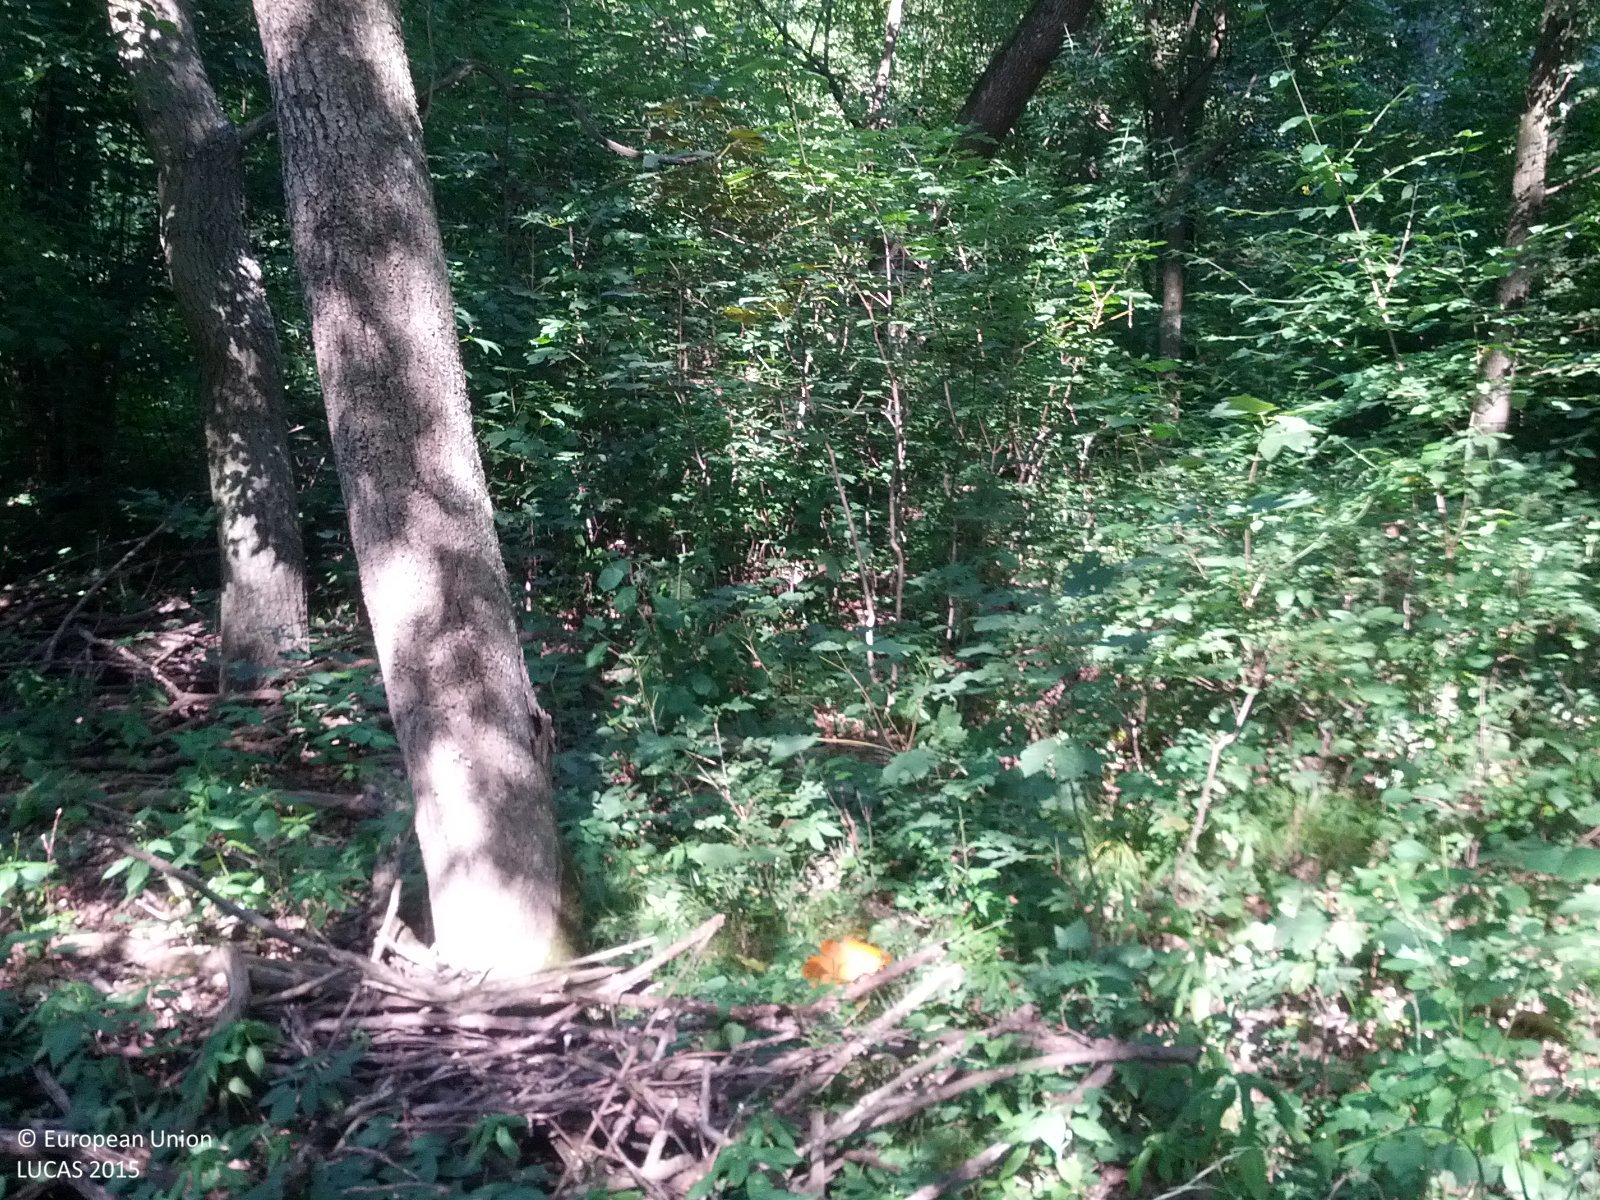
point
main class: Woodland
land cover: Broadleaved woodland
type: floodplain forest
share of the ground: > 75 %
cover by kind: broadleaved forest trees 80 %, herbaceous plants 15 %, shrubs 5 %
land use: Forestry
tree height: > 5 m
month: July
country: AT
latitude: 48.3753
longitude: 16.1744
